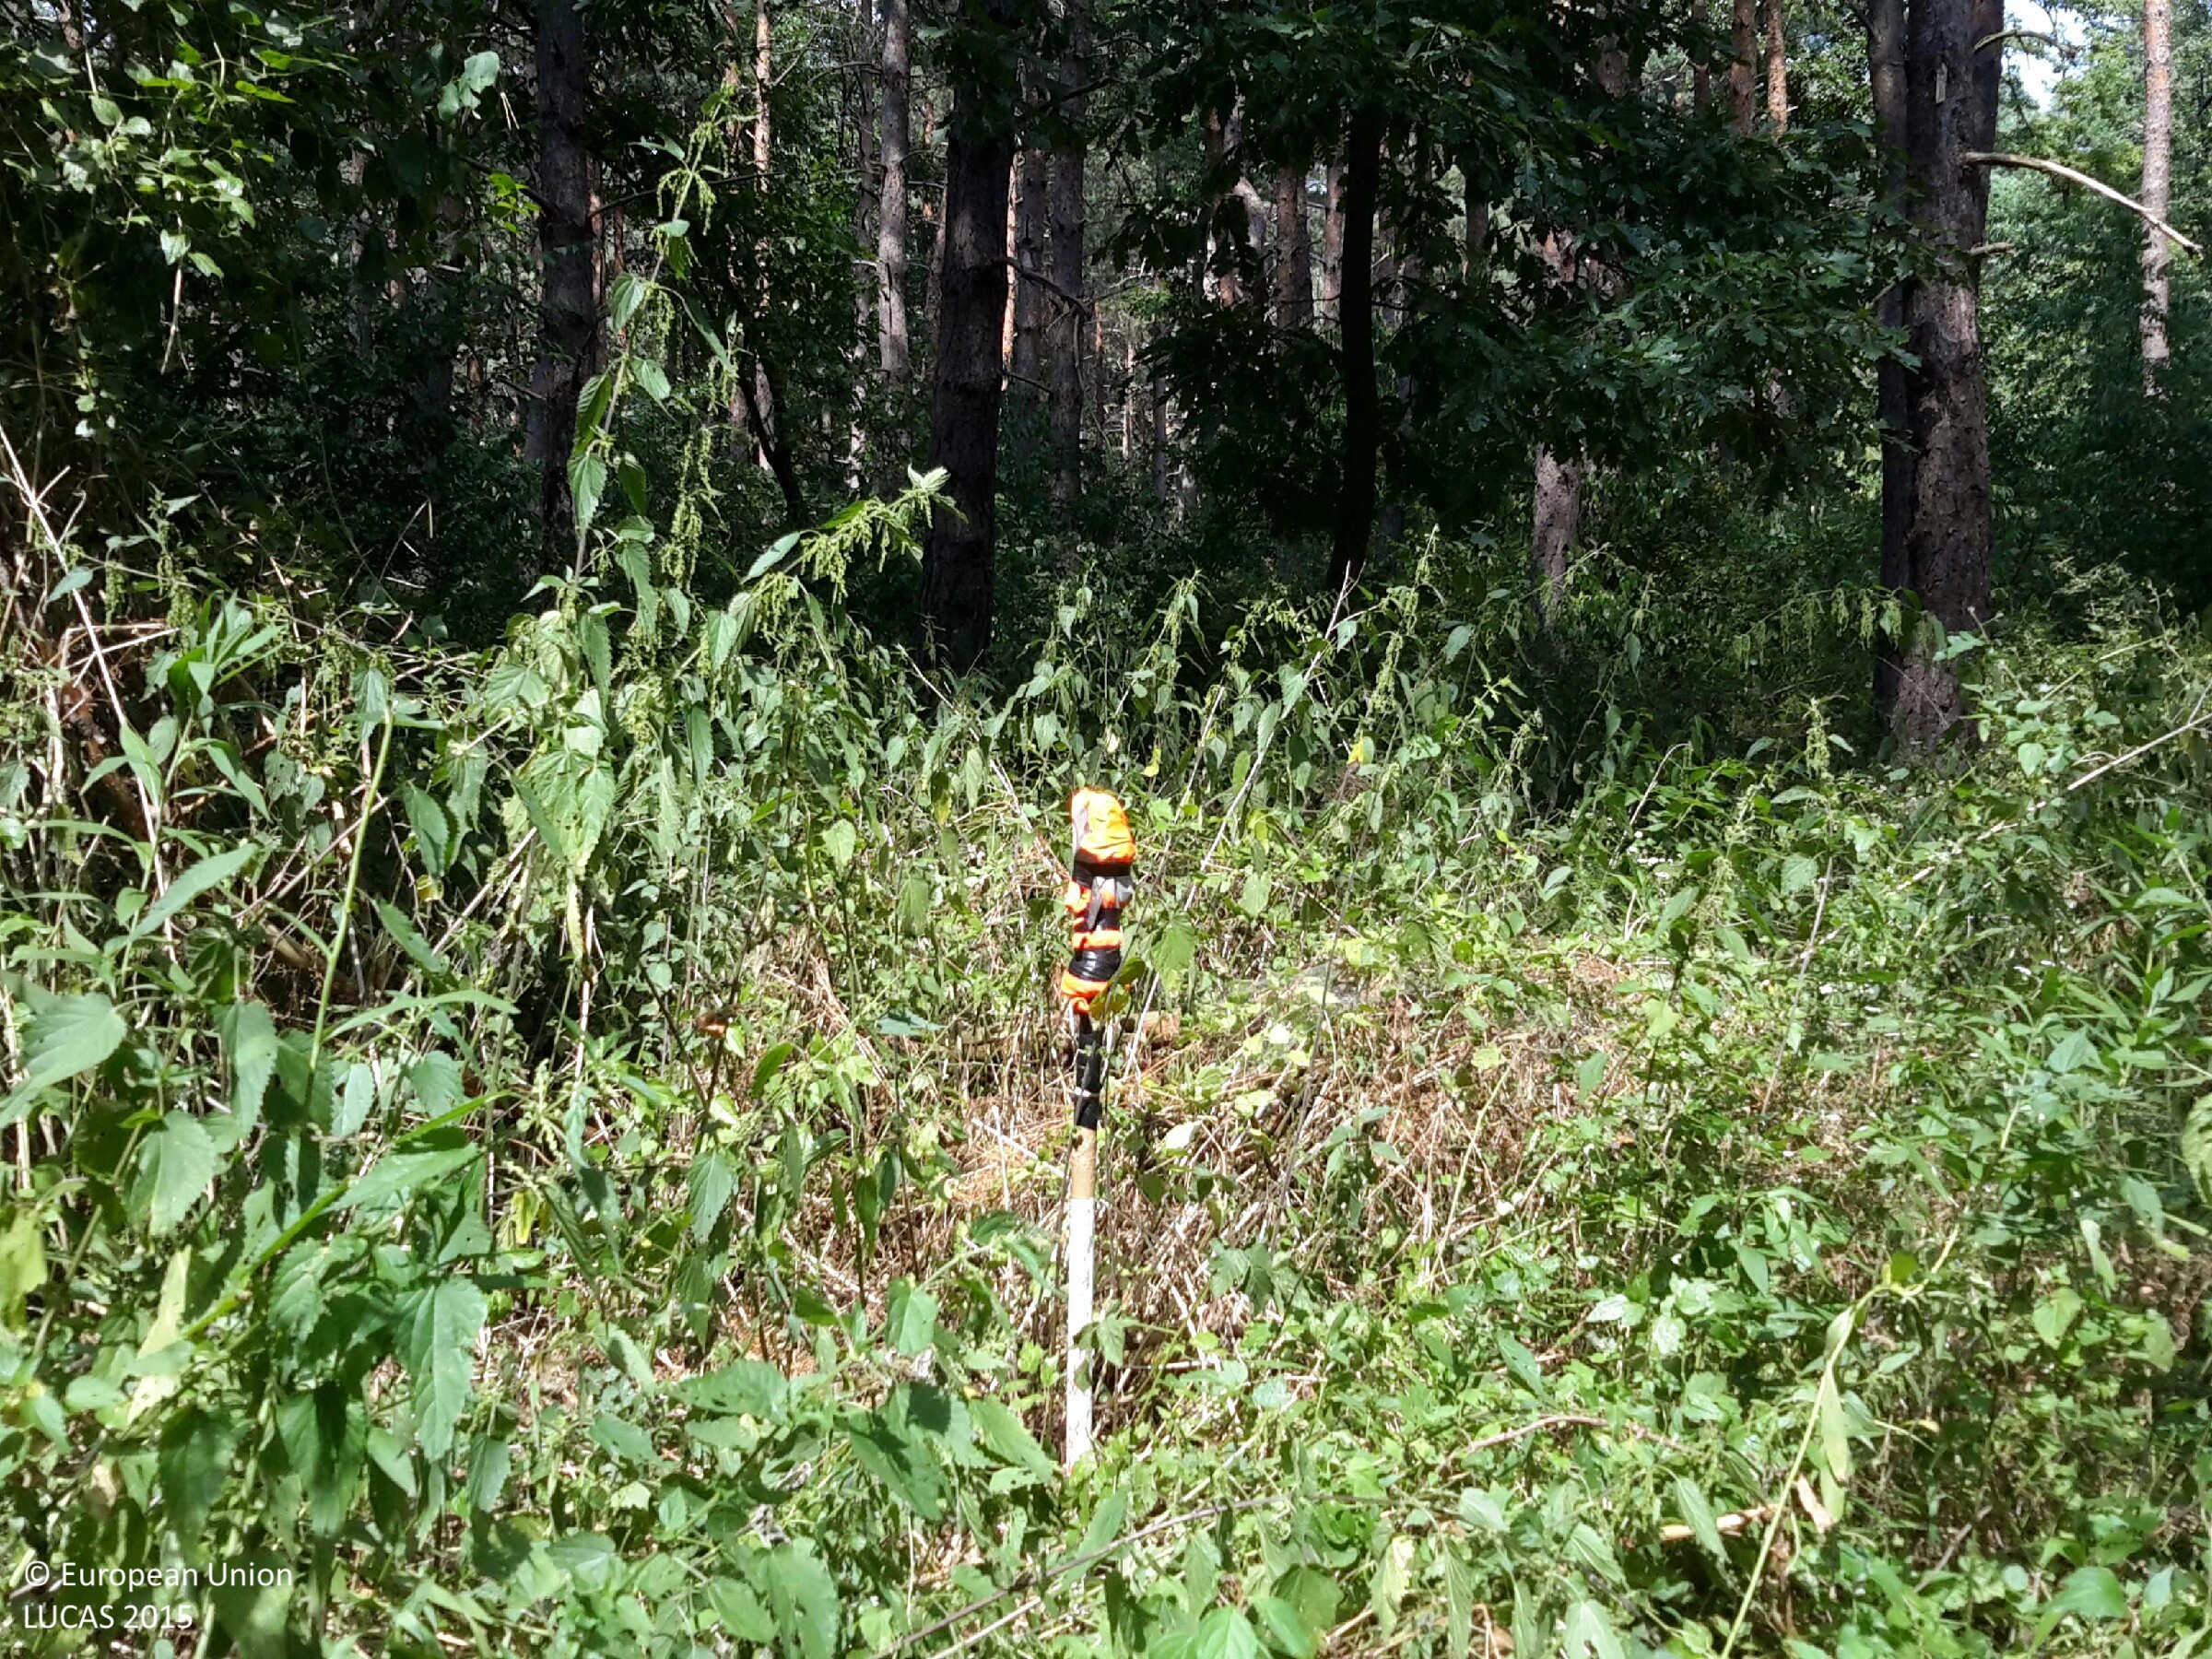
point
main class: Woodland
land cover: Spruce dominated coniferous woodland
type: hemiboreal forest and nemoral coniferous forest and mixed broadleaved-coniferous forest
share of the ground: > 75 %
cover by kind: coniferous forest trees 85 %, herbaceous plants 10 %, broadleaved forest trees 5 %
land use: Forestry
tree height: > 5 m
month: July
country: HU
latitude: 47.3536
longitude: 17.7535
